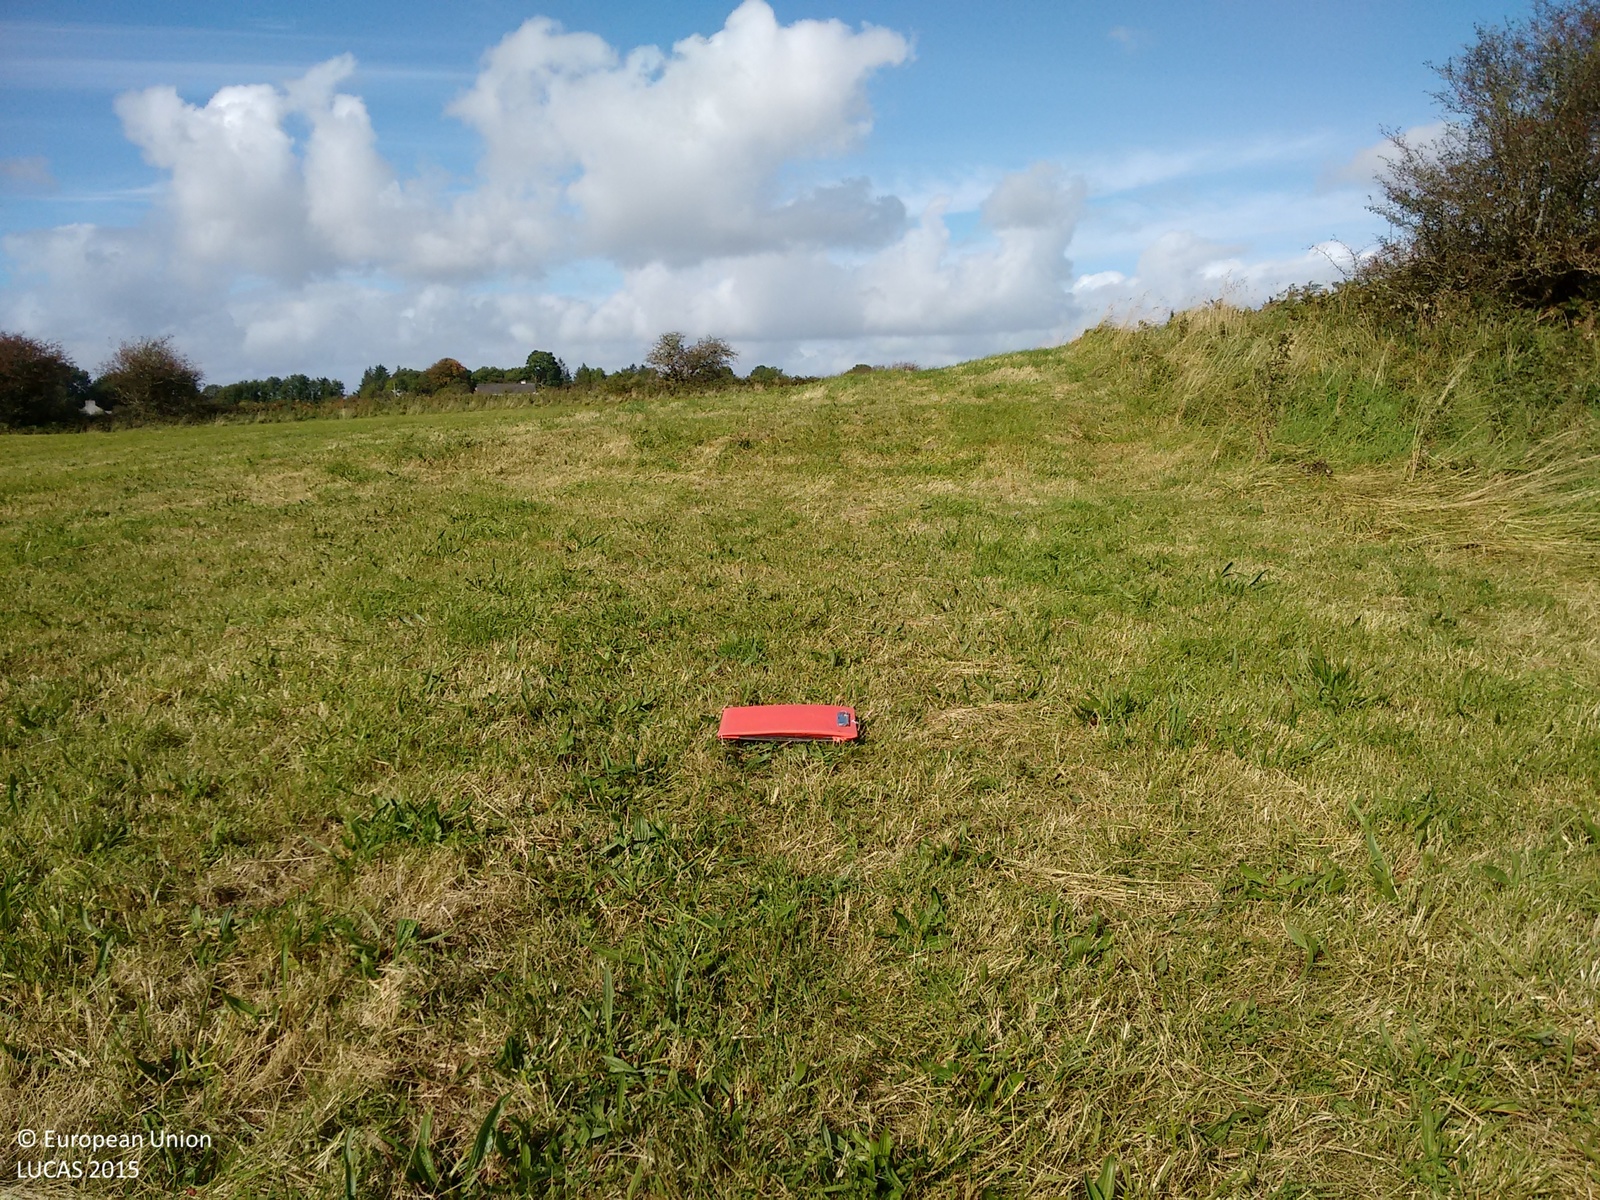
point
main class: Grassland
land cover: Grassland without tree/shrub cover
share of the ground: > 75 %
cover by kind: herbaceous plants 100 %
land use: Agriculture (excluding fallow land and kitchen gardens)
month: September
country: IE
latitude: 53.8134
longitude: -8.8095
